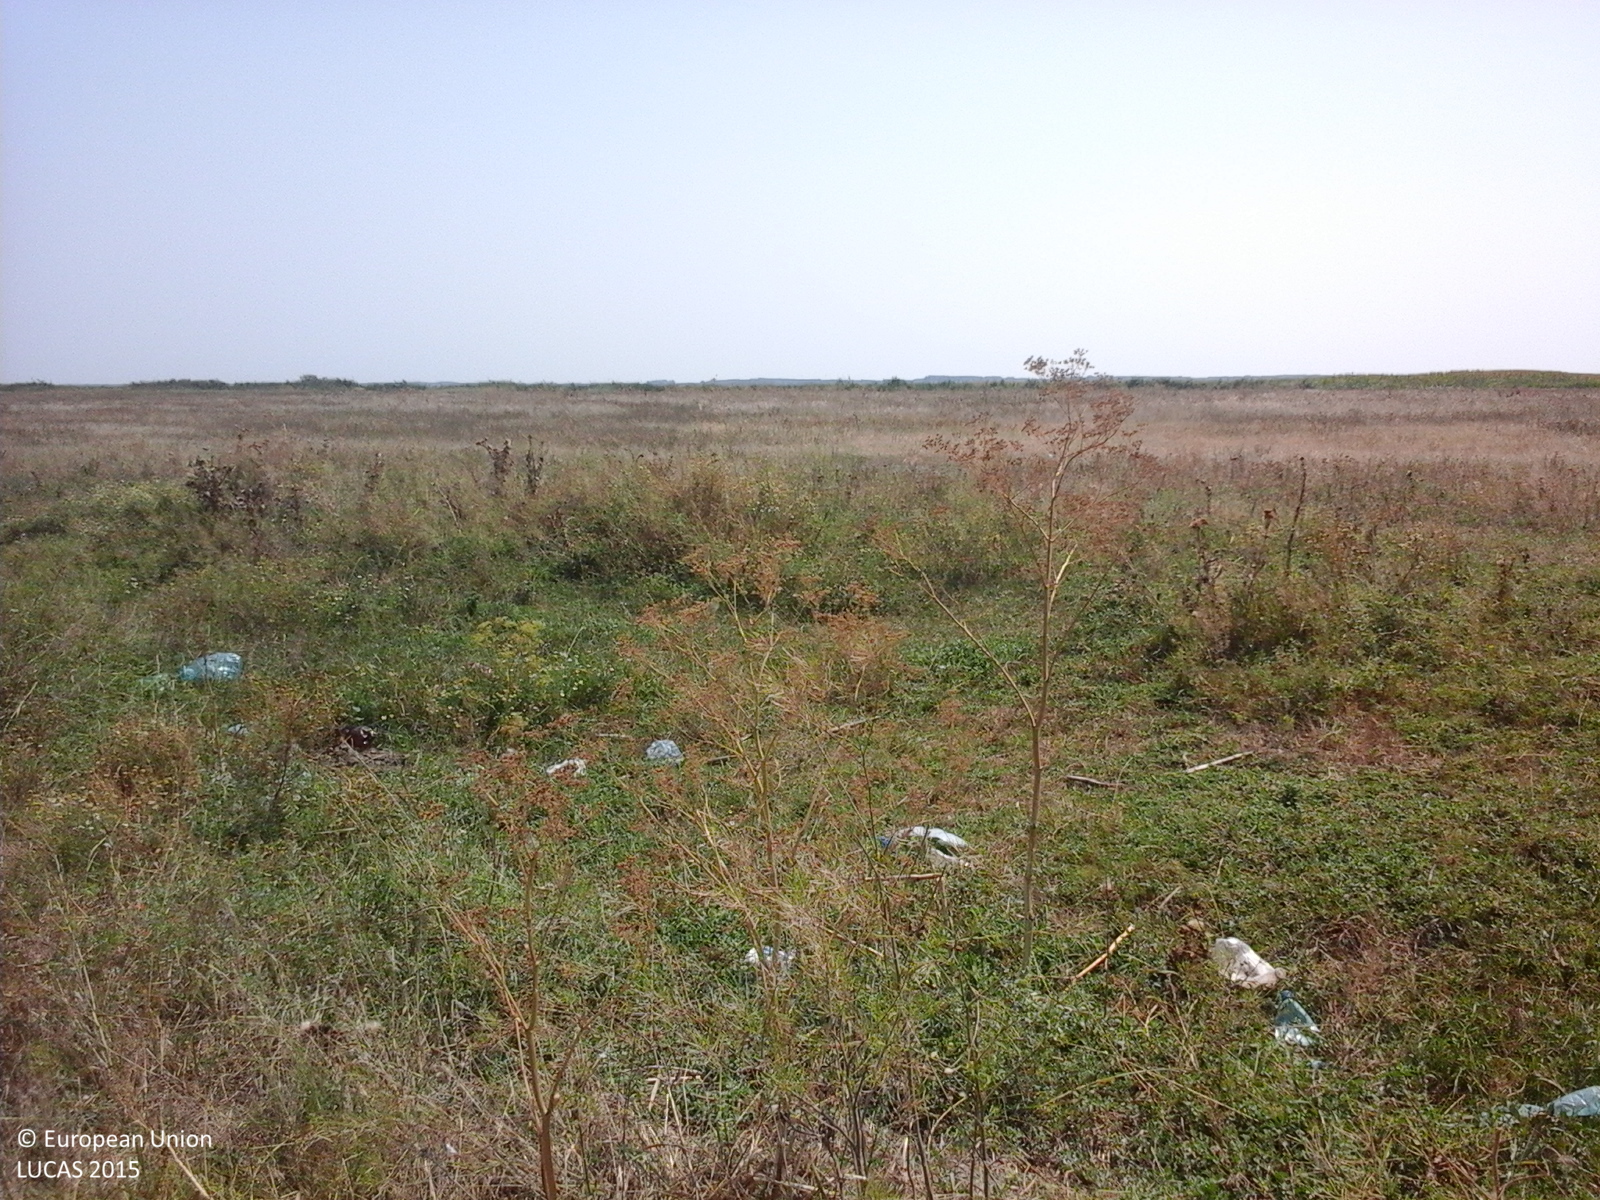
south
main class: Grassland
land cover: Spontaneously vegetated surfaces
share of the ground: > 75 %
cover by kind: herbaceous plants 100 %
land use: Fallow land
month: July
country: RO
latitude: 45.4558
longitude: 27.7699
